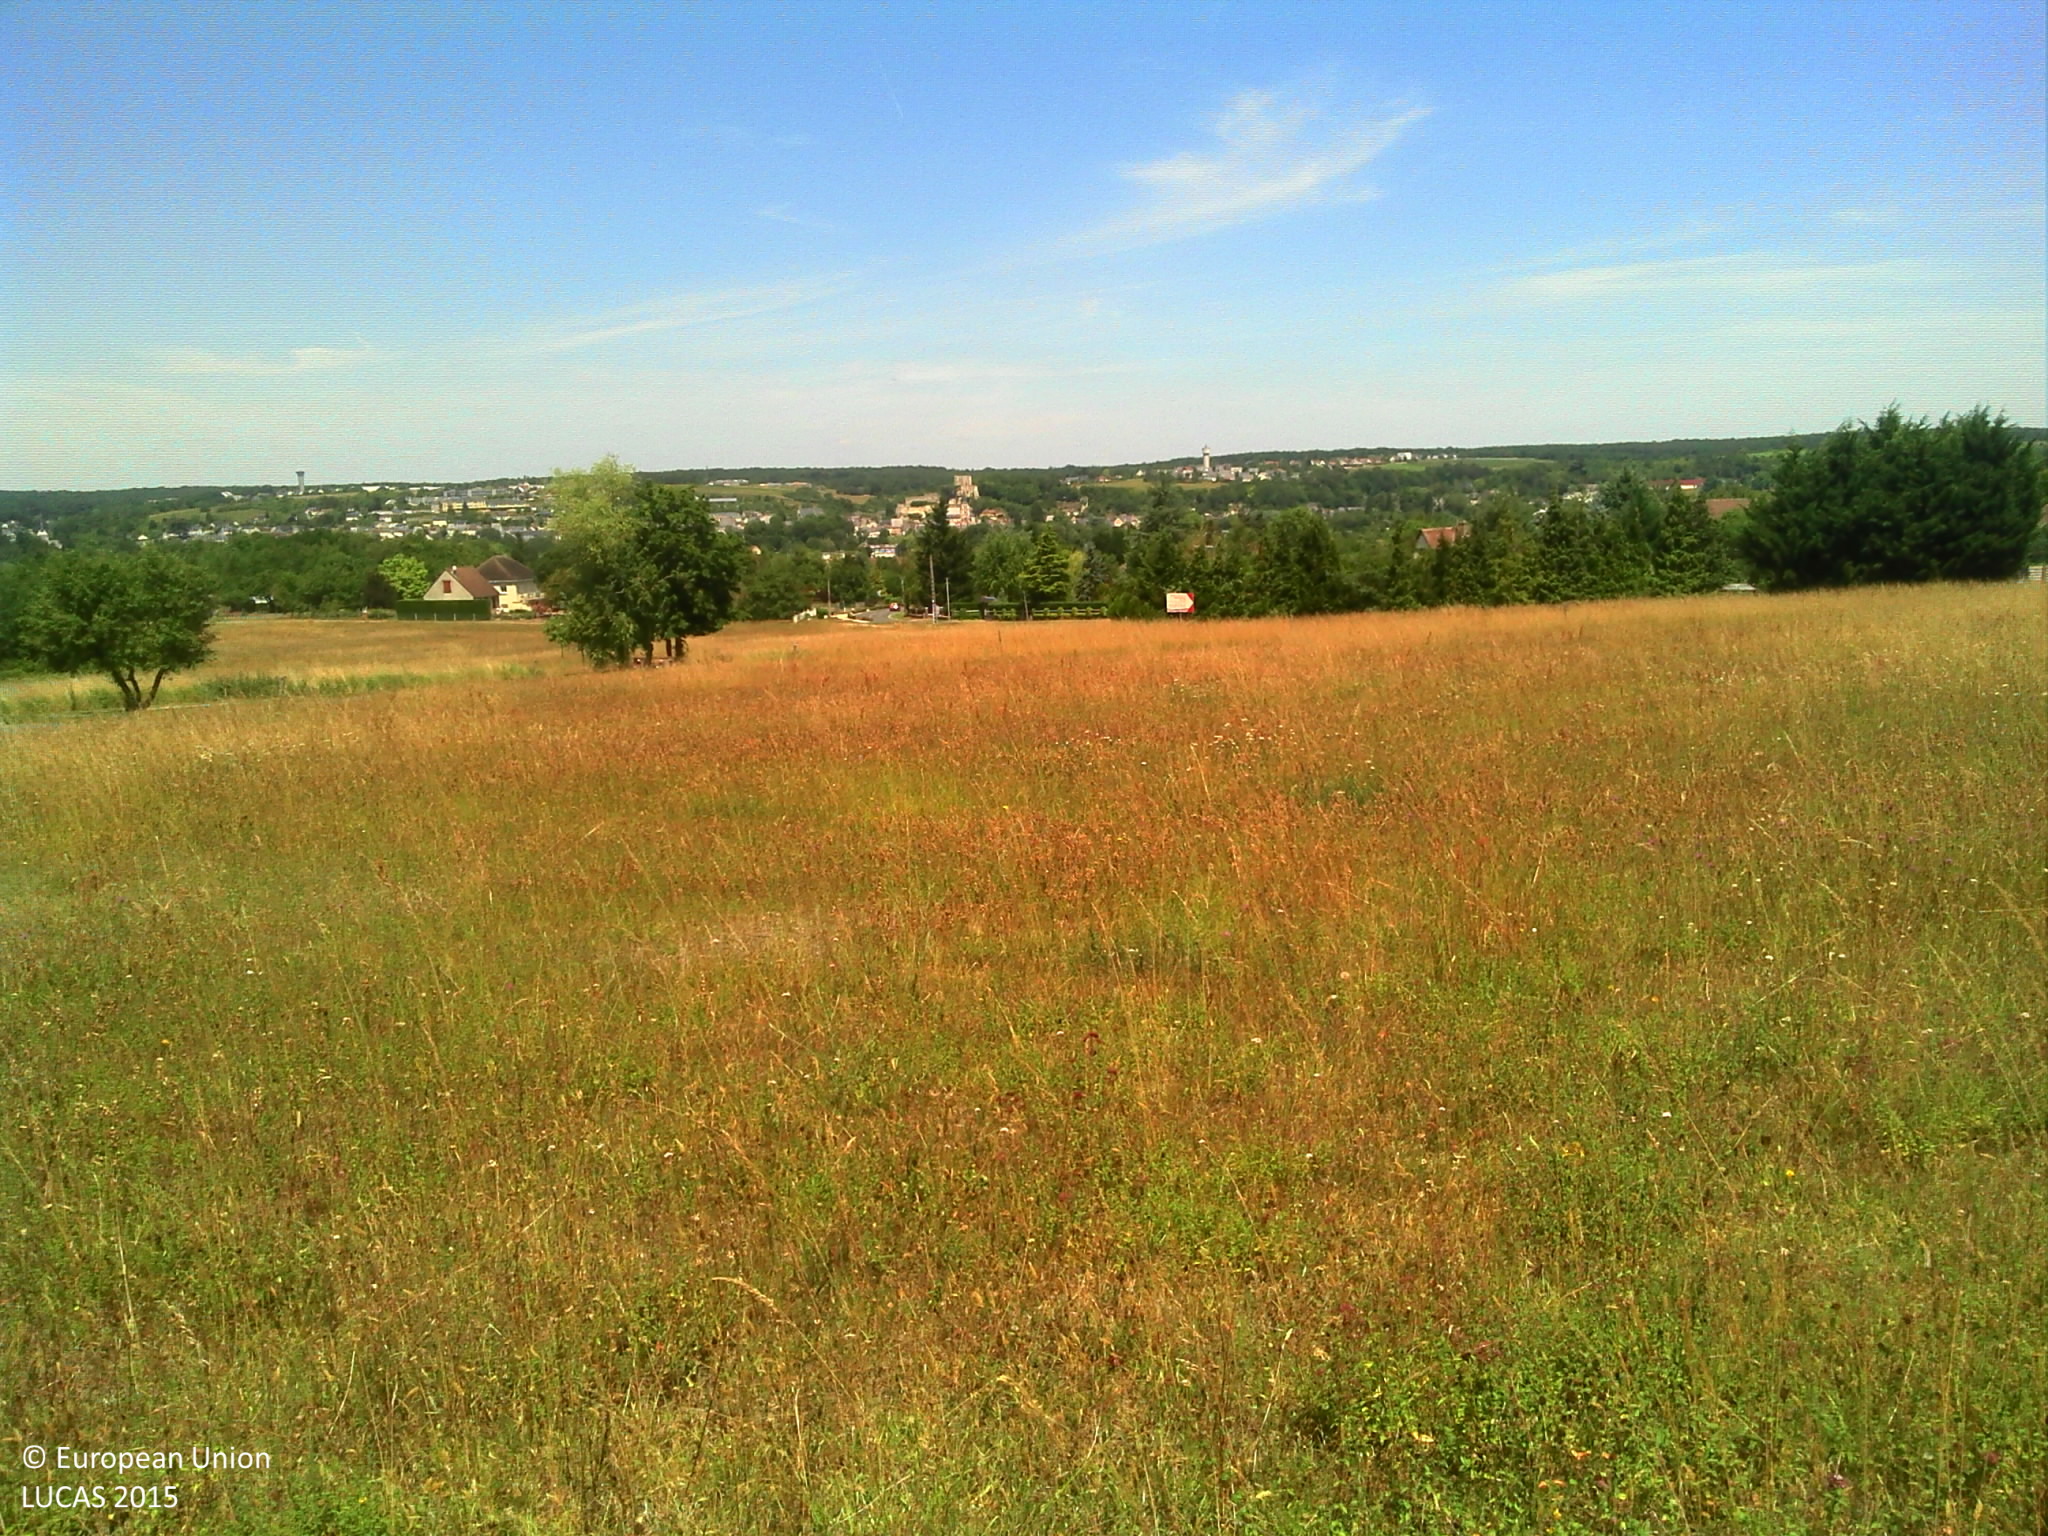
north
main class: Grassland
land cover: Grassland without tree/shrub cover
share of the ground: > 75 %
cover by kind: herbaceous plants 100 %
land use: Agriculture (excluding fallow land and kitchen gardens)
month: June
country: FR
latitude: 47.3268
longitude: 1.1854
